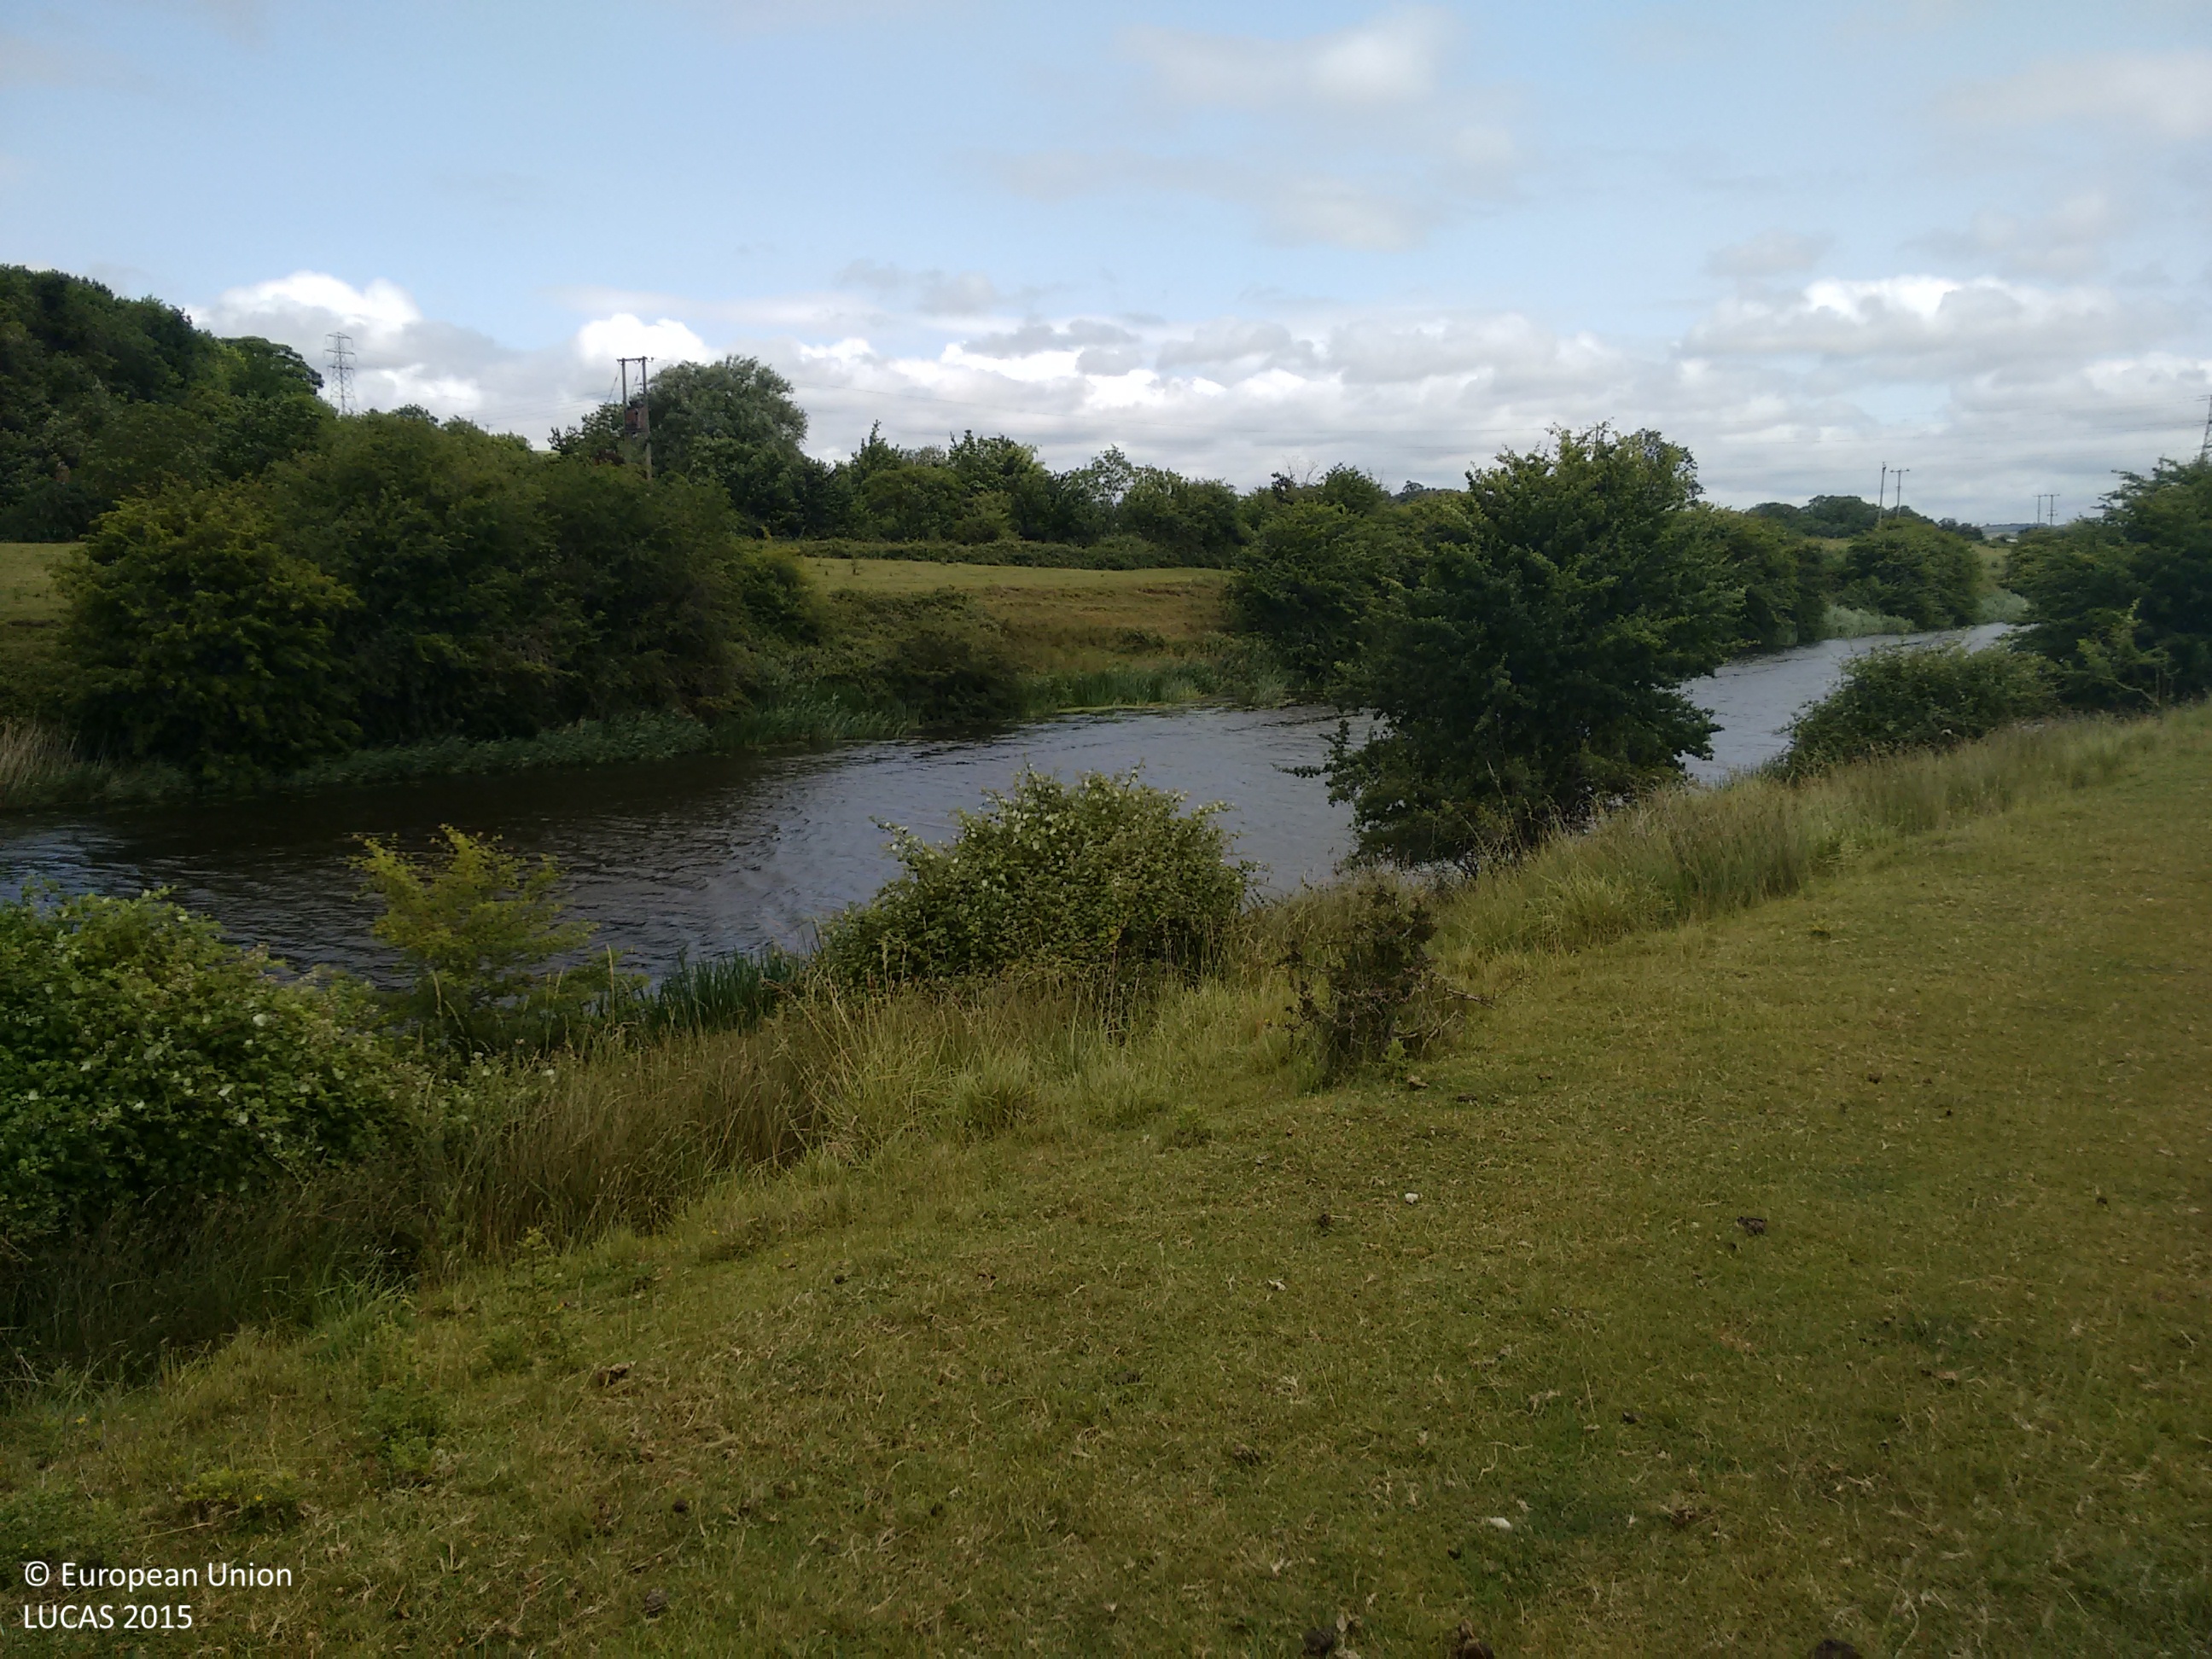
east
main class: Grassland
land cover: Grassland without tree/shrub cover
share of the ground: > 75 %
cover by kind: herbaceous plants 100 %
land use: Agriculture (excluding fallow land and kitchen gardens)
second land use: Amenities, museums, leisure
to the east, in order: Grassland without tree/shrub cover; Inland fresh running water; Grassland with sparse tree/shrub cover; Electric lines; Groves; Electric lines; Grassland without tree/shrub cover; Abandoned hedges; Grassland with sparse tree/shrub cover; Fences; Arable land (only in case pi)
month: July
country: GB
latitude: 51.1535
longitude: -2.9558
